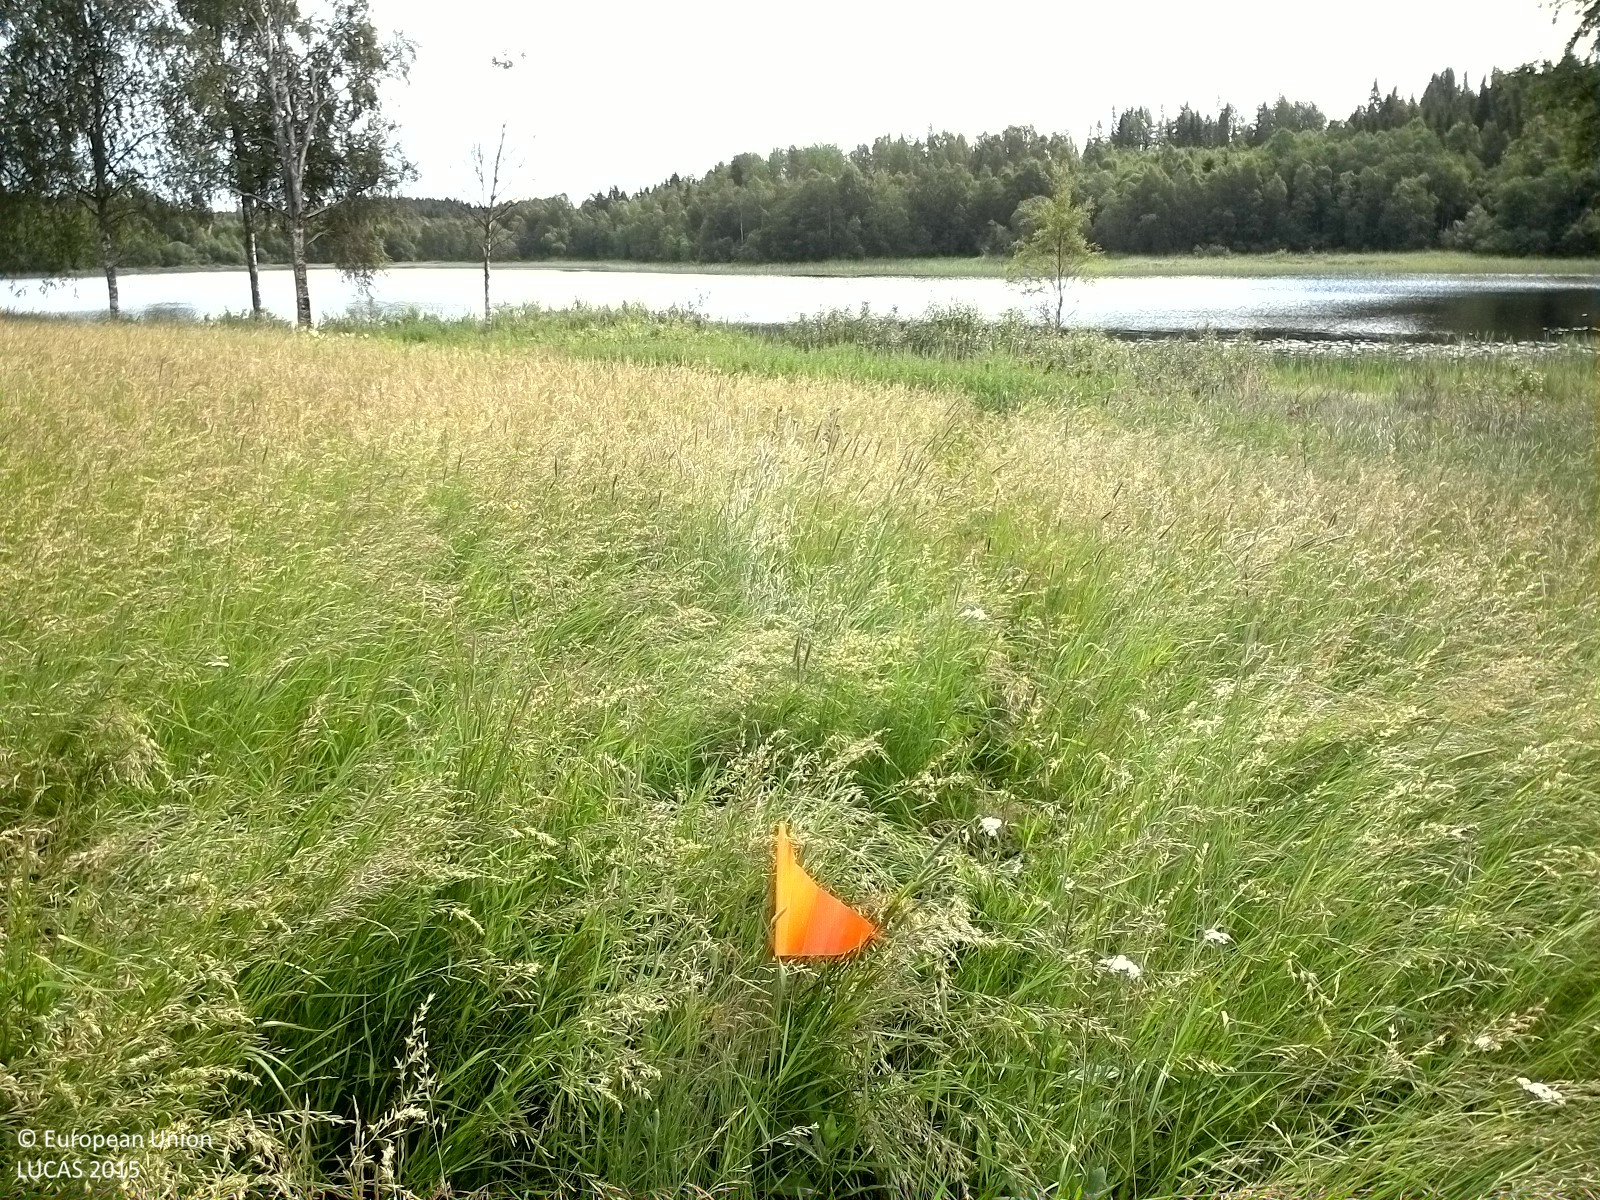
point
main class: Cropland
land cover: Other leguminous and mixtures for fodder
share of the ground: > 75 %
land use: Agriculture (excluding fallow land and kitchen gardens)
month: July
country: SE
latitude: 62.5103
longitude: 17.6121
